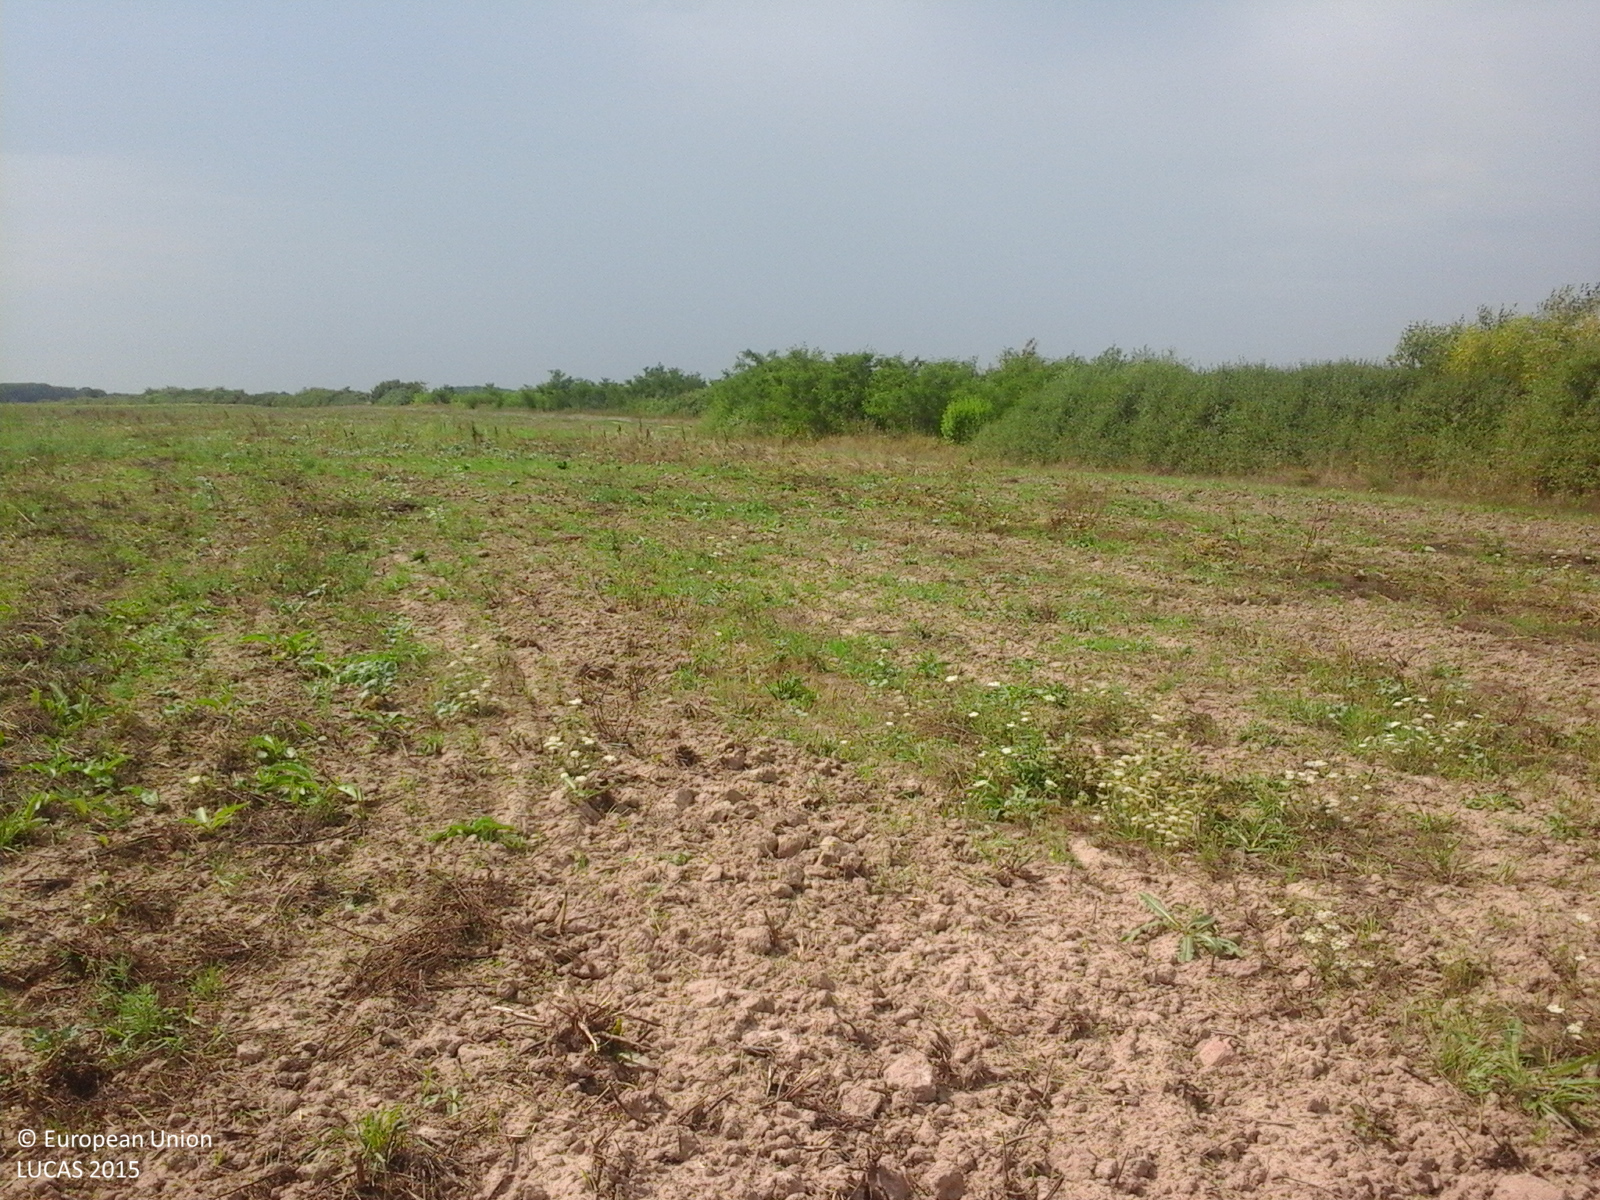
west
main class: Grassland
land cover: Spontaneously vegetated surfaces
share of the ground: 25 - 50 %
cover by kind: herbaceous plants 100 %
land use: Fallow land
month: August
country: RO
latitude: 46.5720
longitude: 21.7713
